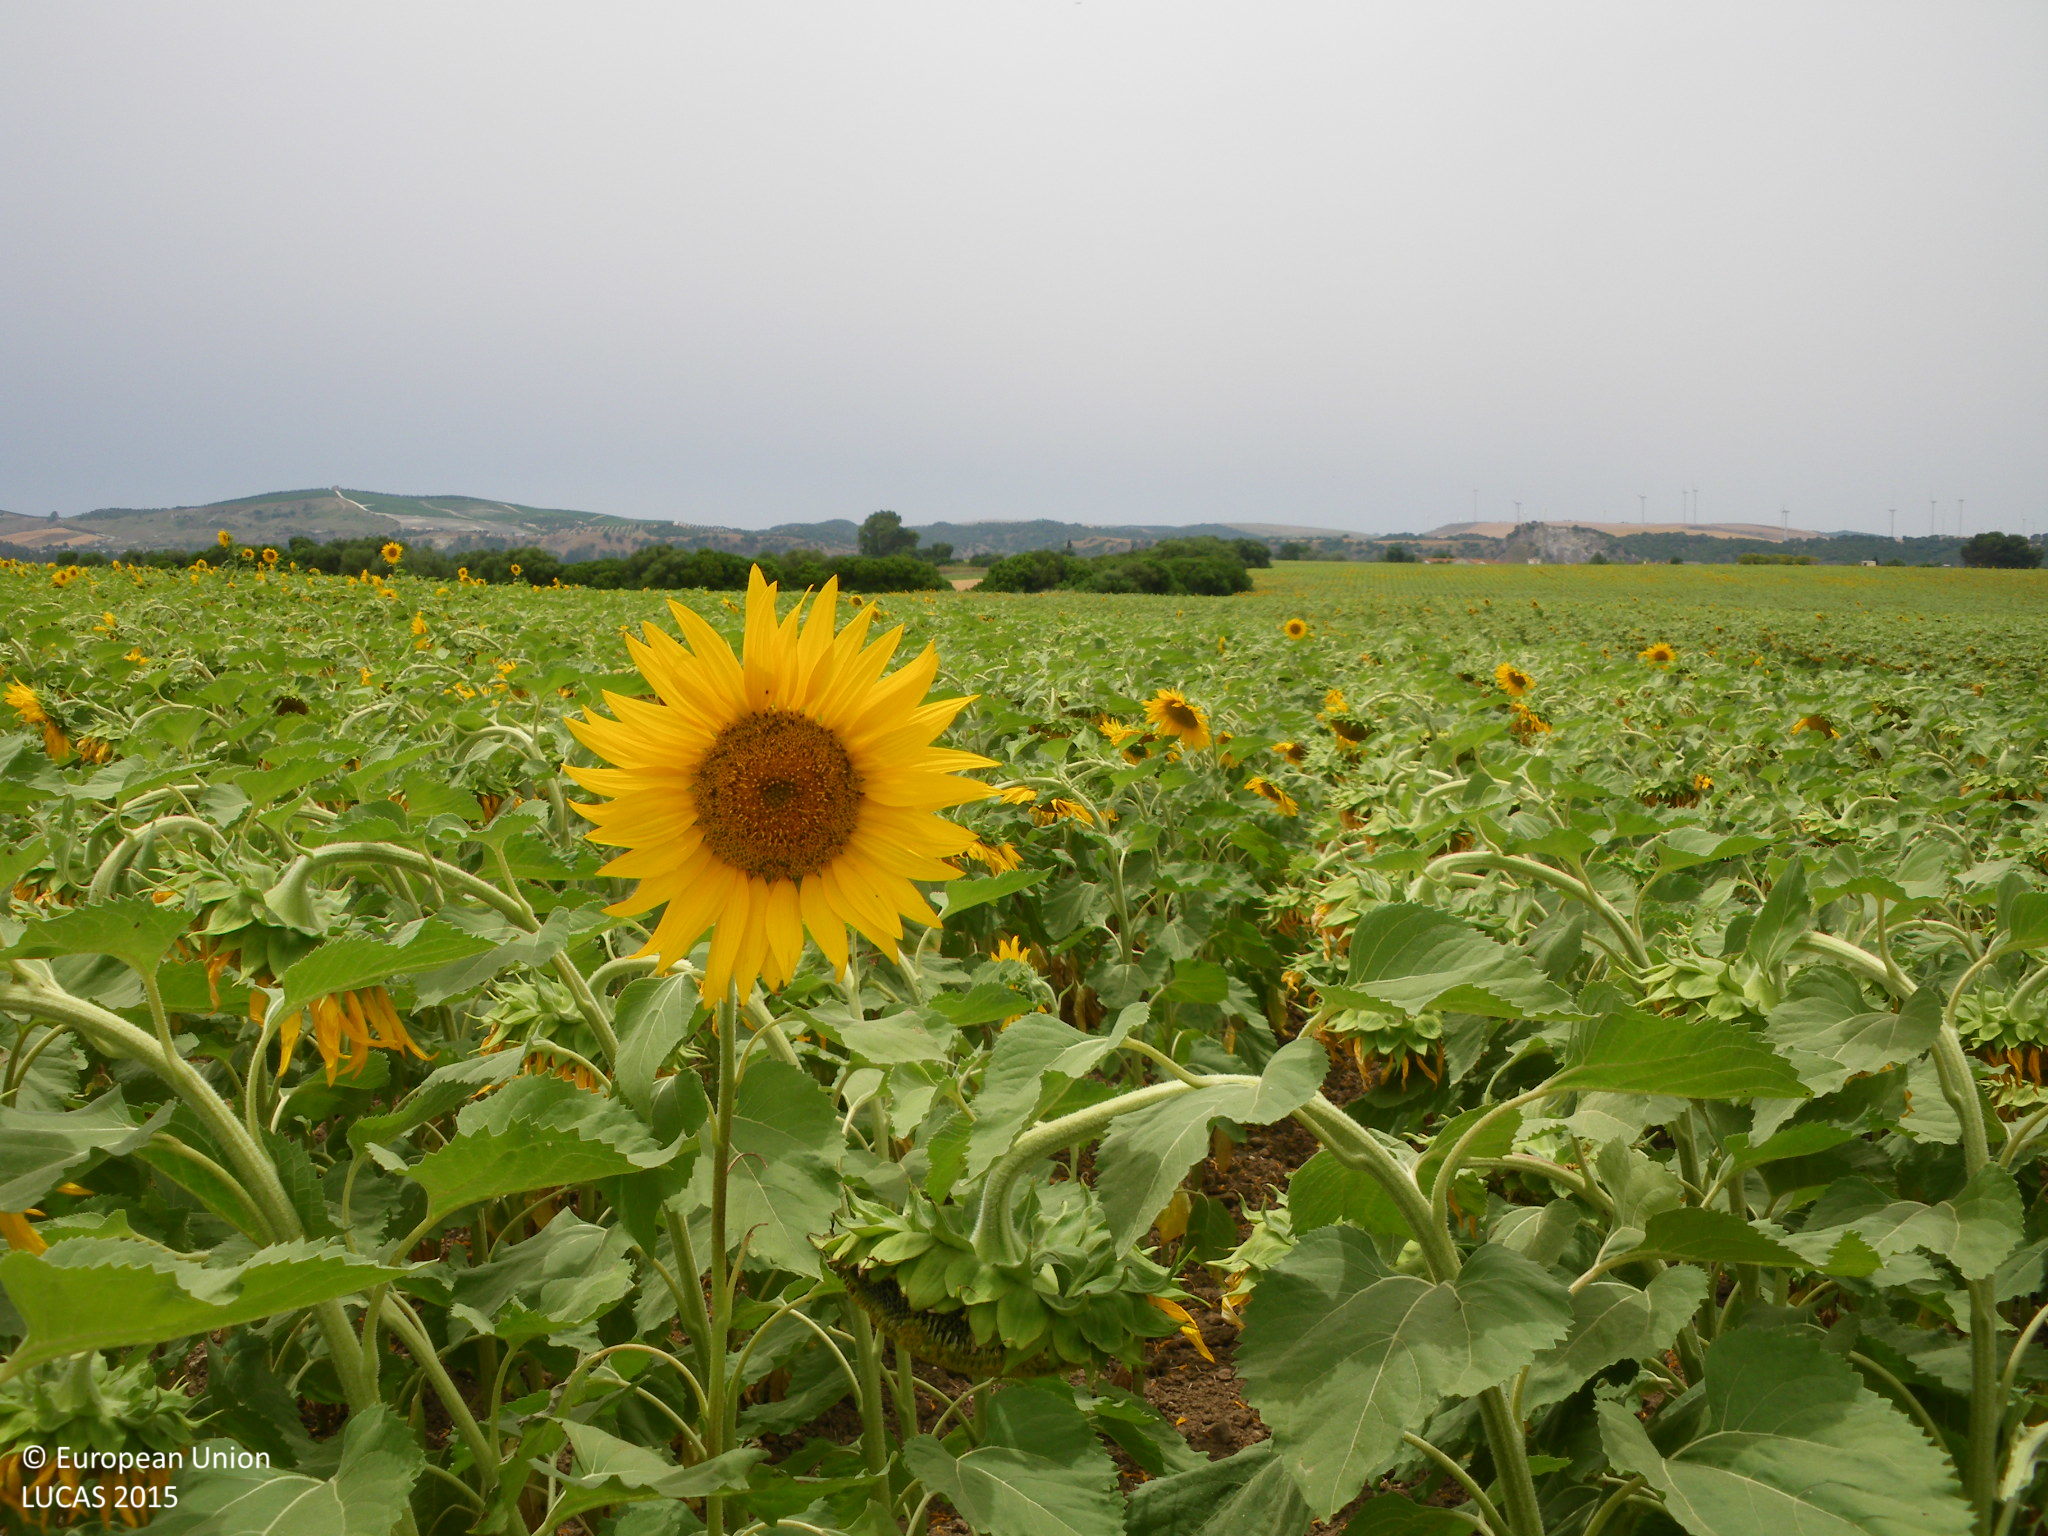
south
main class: Cropland
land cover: Sunflower
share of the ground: > 75 %
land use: Agriculture (excluding fallow land and kitchen gardens)
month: June
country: ES
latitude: 36.6288
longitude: -5.9664
